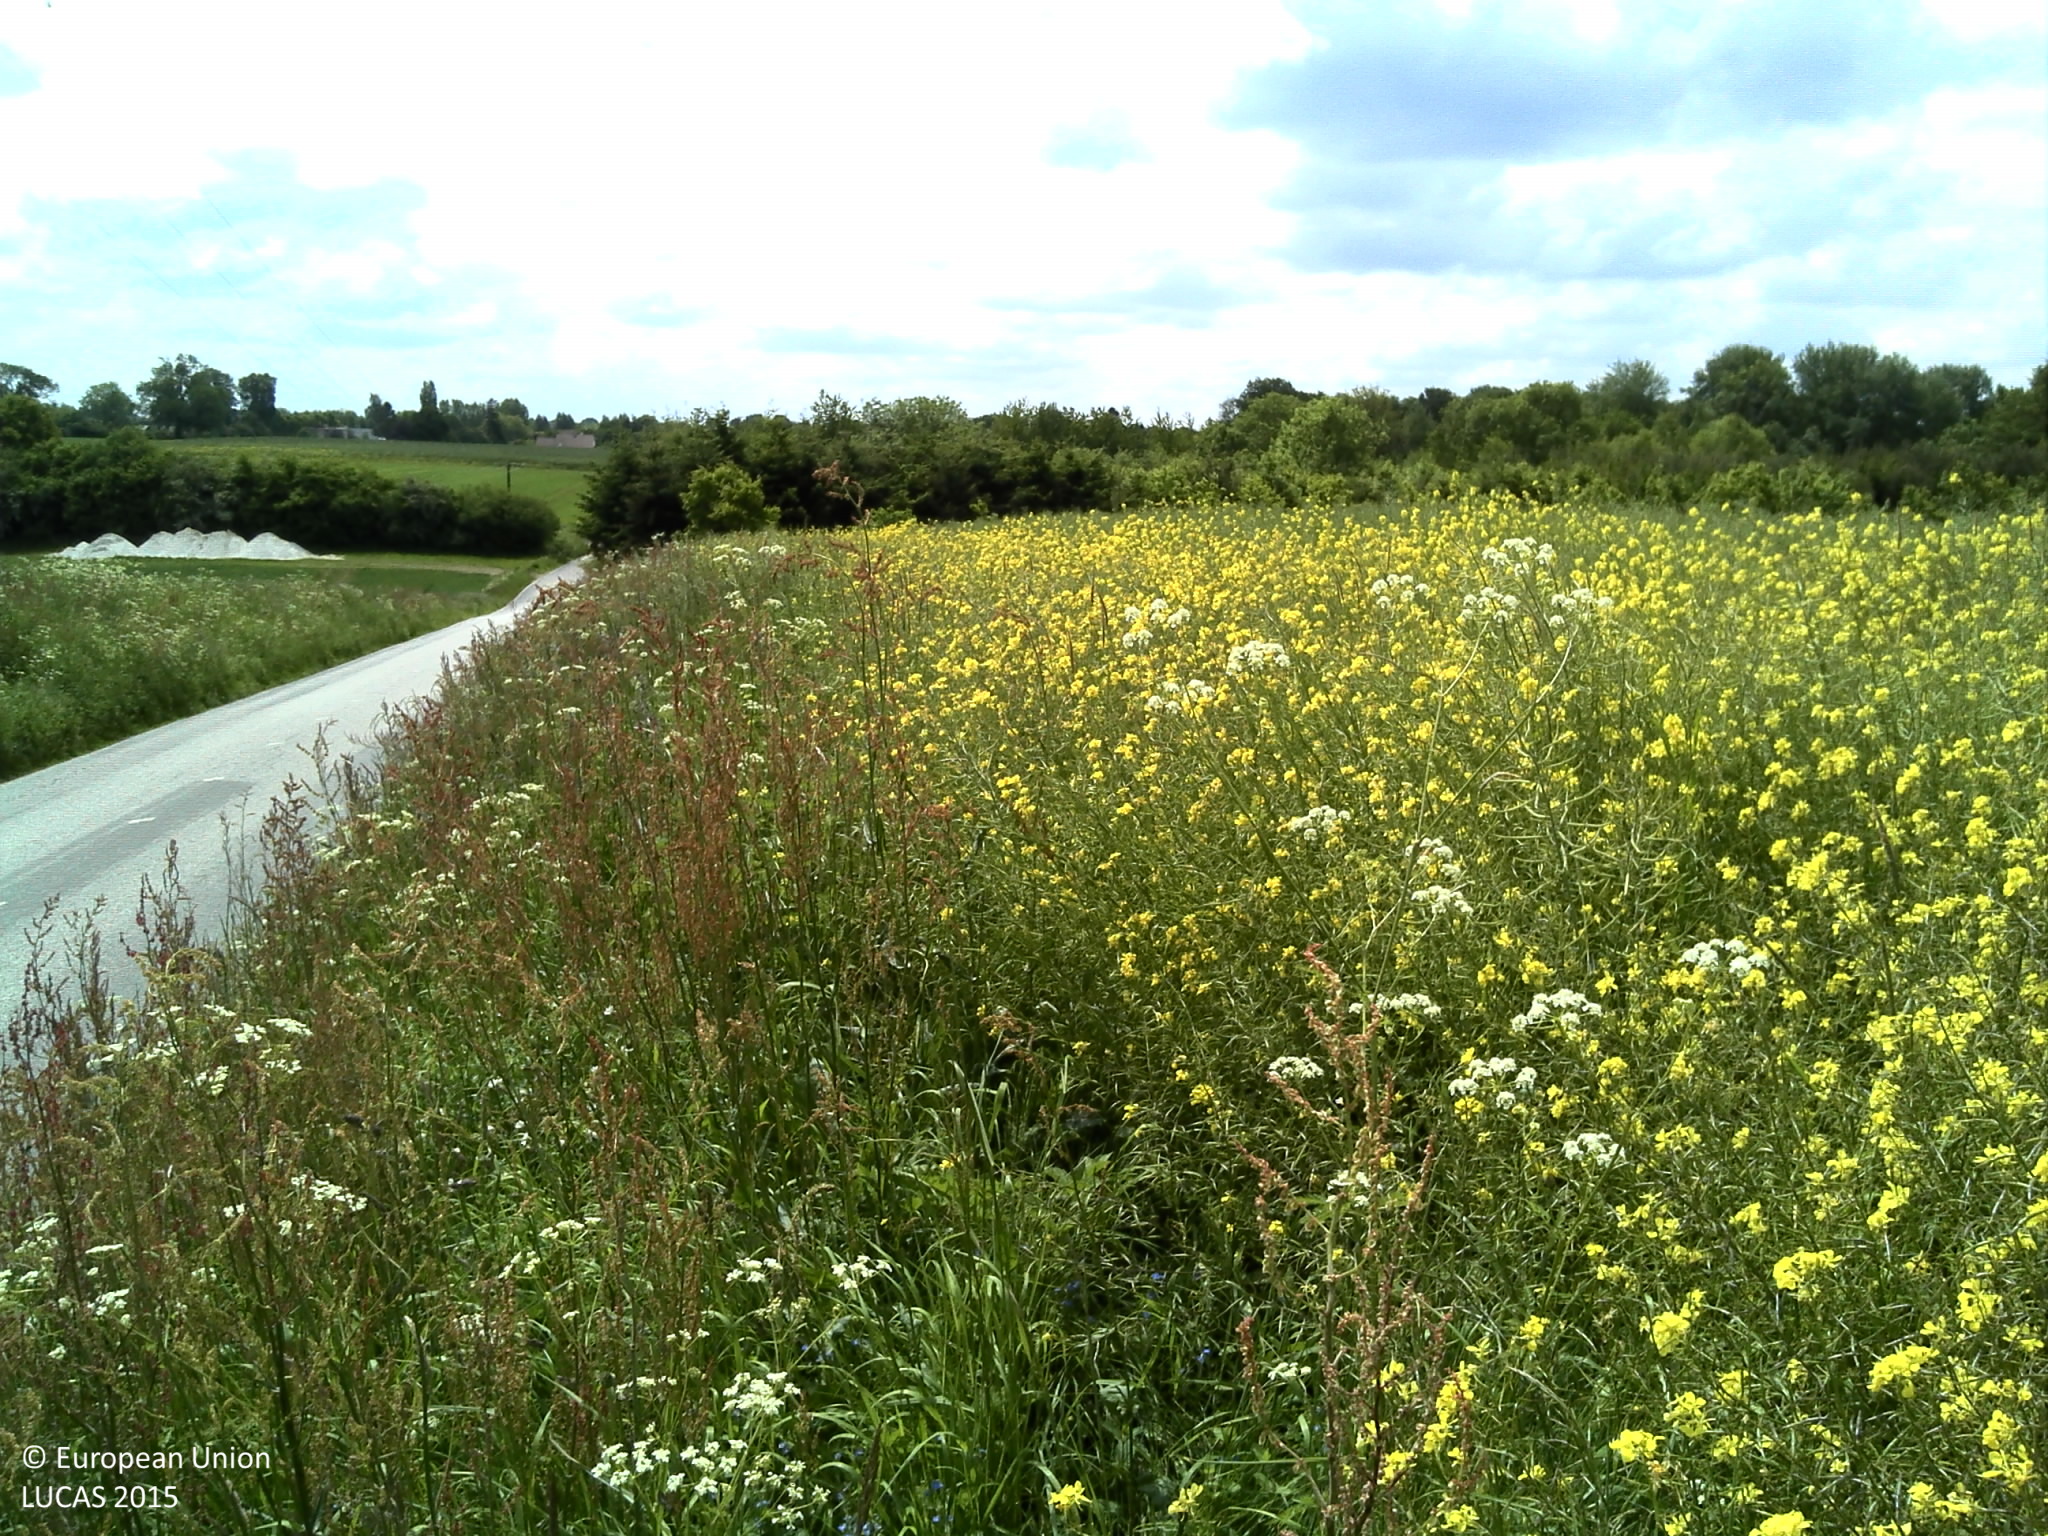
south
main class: Cropland
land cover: Rape and turnip rape
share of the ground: > 75 %
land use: Agriculture (excluding fallow land and kitchen gardens)
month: May
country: FR
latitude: 49.5341
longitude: 1.1772
